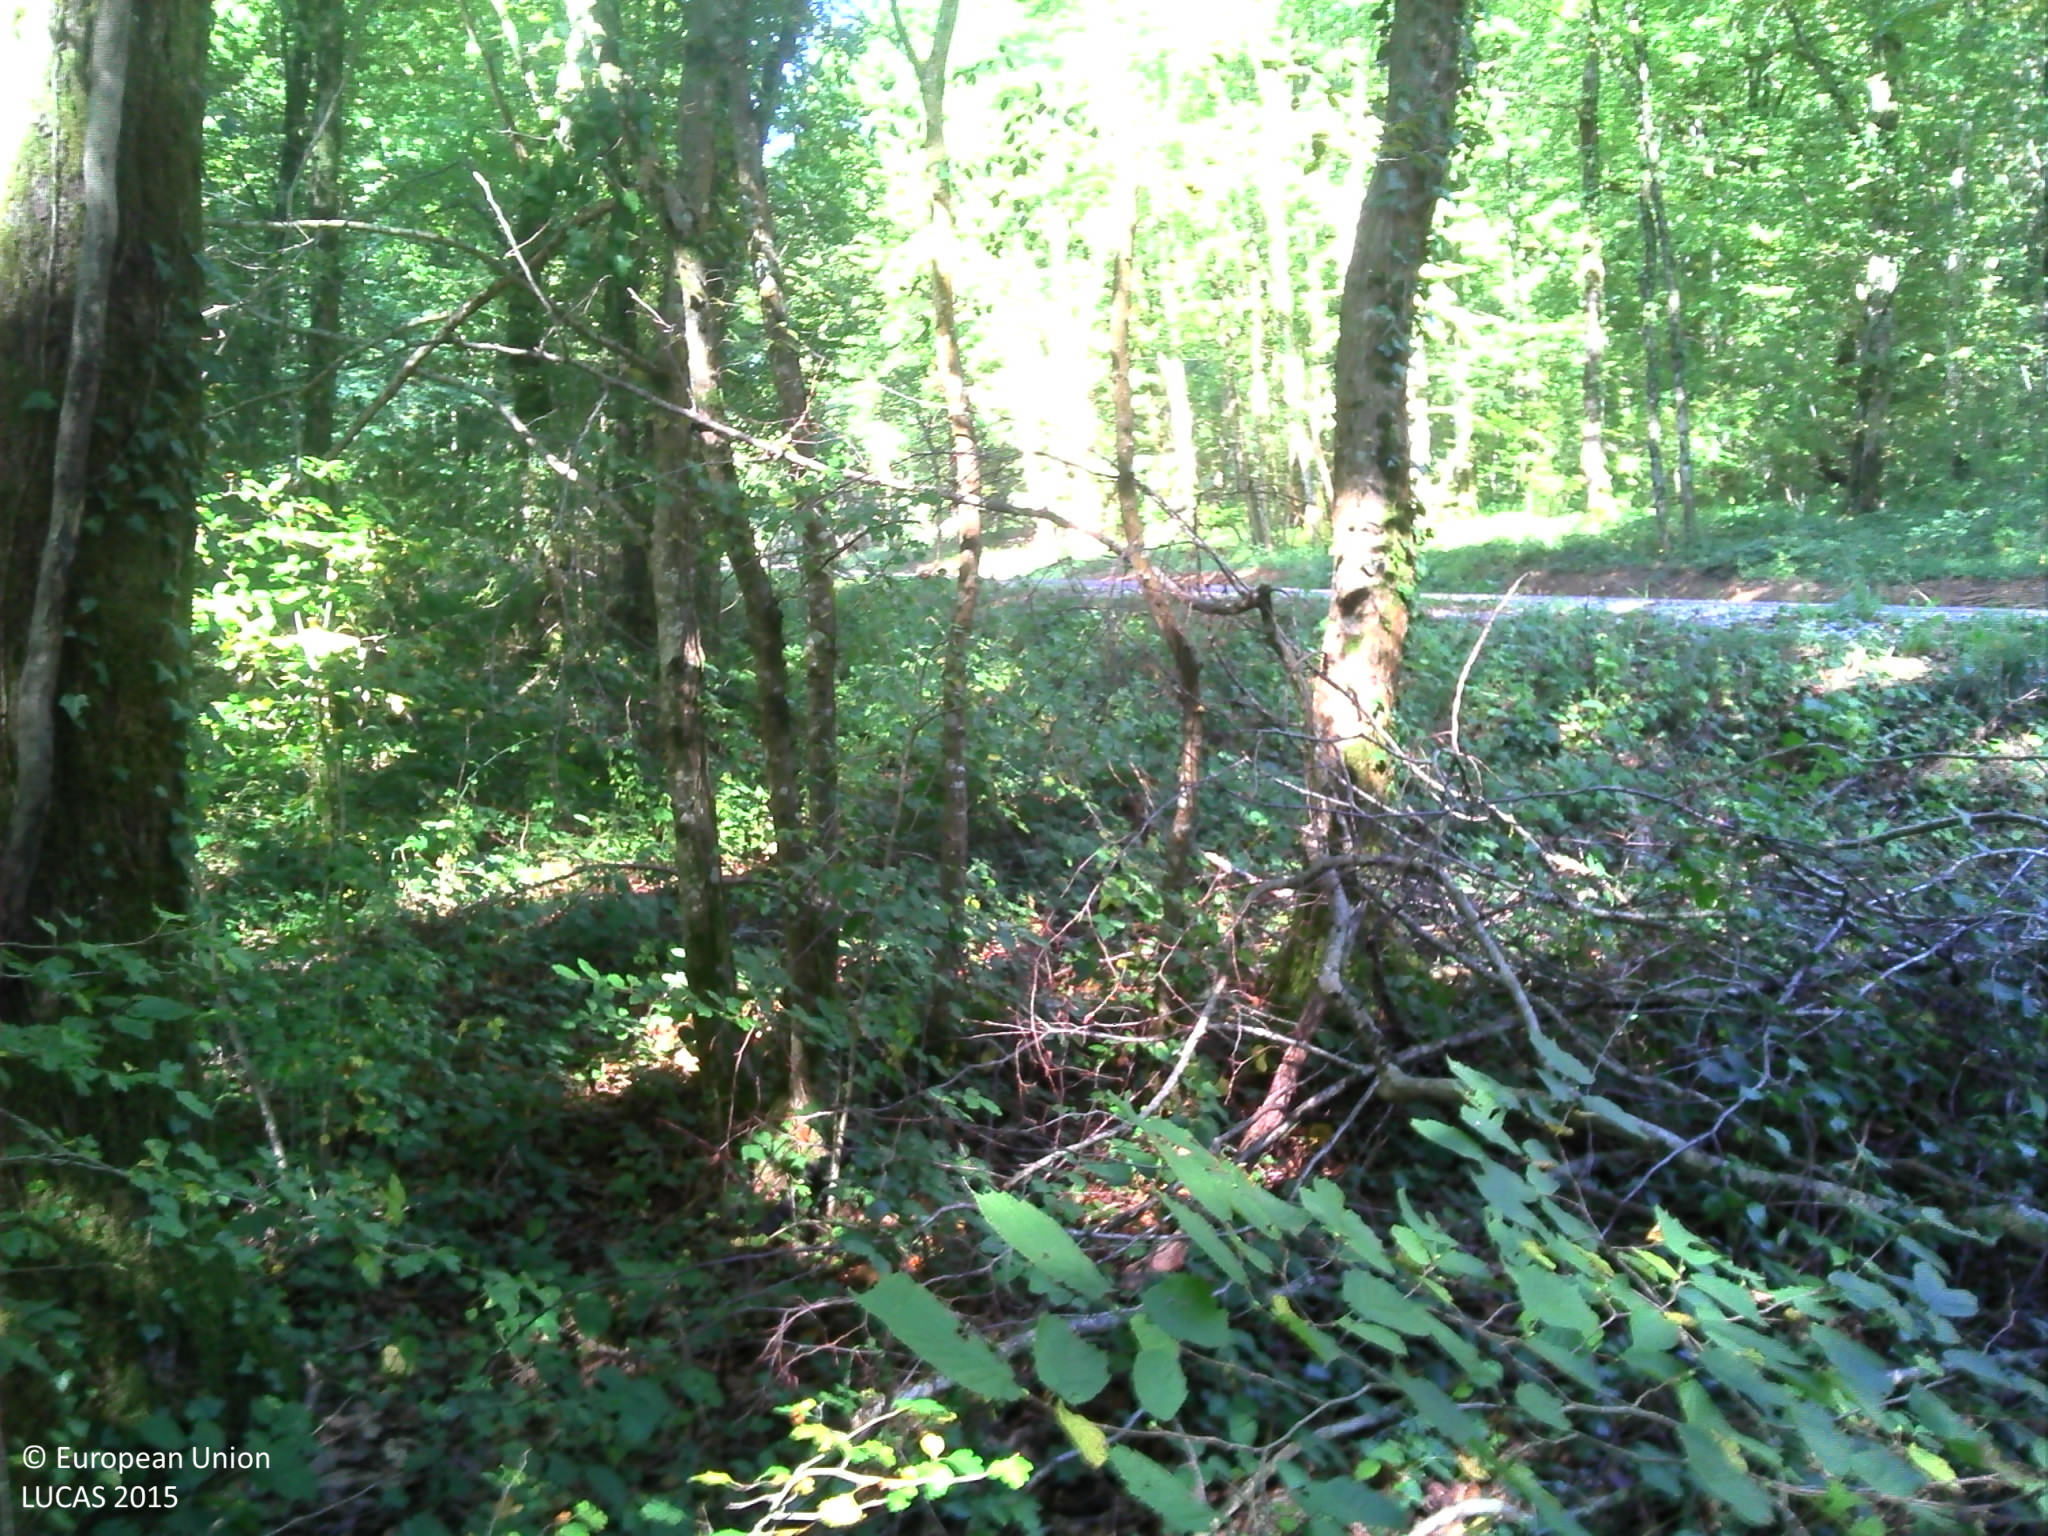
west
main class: Woodland
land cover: Broadleaved woodland
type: beech forest
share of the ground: > 75 %
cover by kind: broadleaved forest trees 80 %, herbaceous plants 15 %, shrubs 5 %
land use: Forestry
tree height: > 5 m
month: September
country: FR
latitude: 47.3690
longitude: 6.3071
